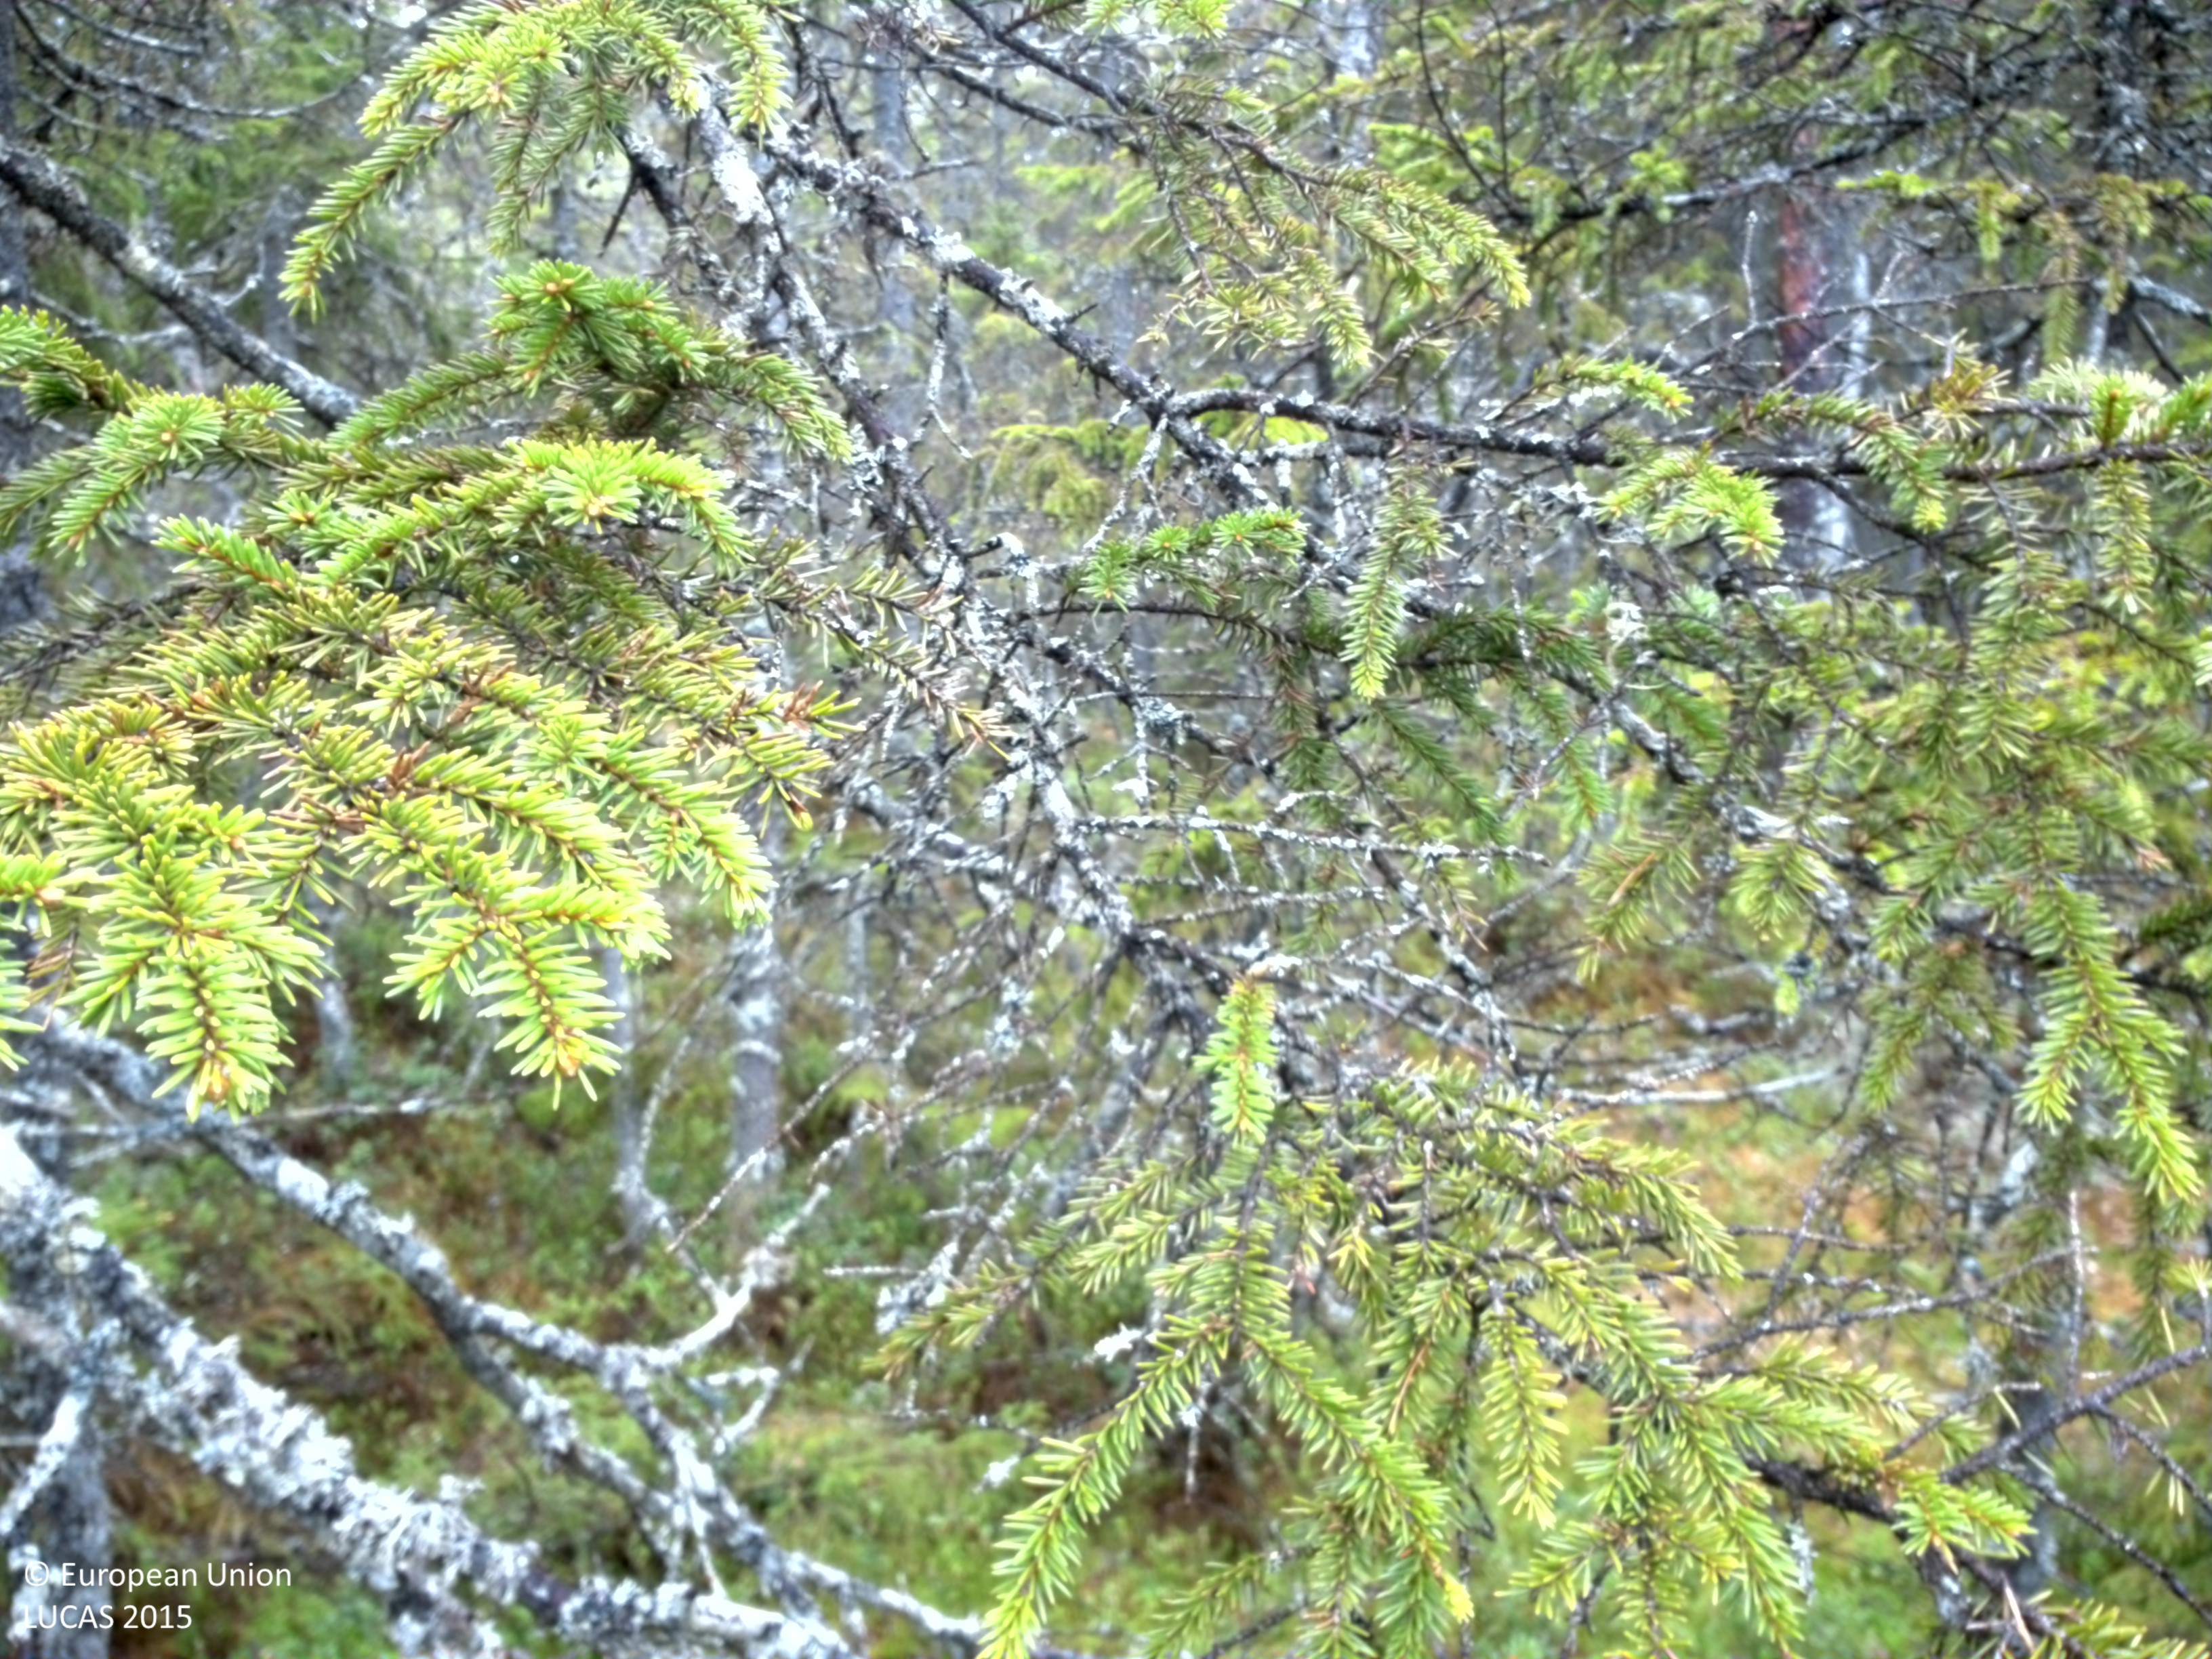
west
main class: Woodland
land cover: Spruce dominated coniferous woodland
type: boreal forest
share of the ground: 25 - 50 %
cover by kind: coniferous forest trees 45 %, shrubs 35 %, lichens and mosses 15 %, herbaceous plants 5 %
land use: Forestry
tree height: > 5 m
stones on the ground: 10 - 25 %
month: June
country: SE
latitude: 60.3598
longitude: 13.2353
